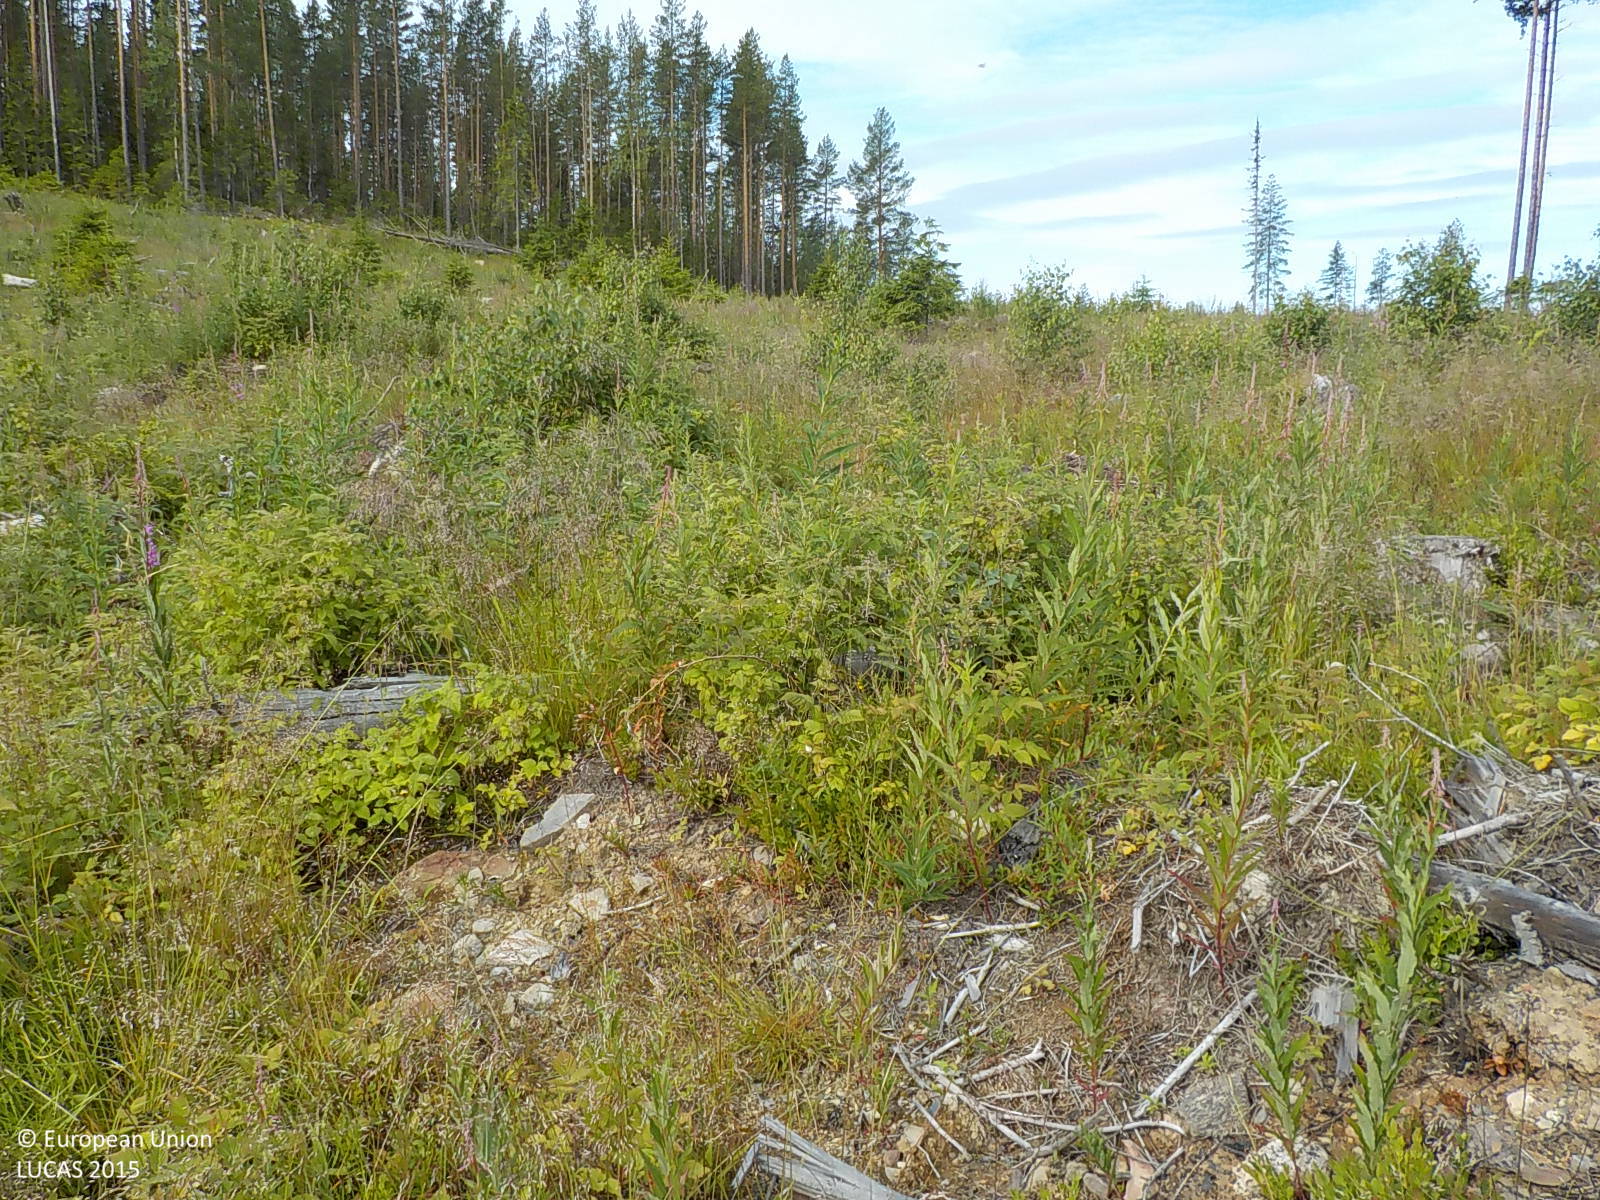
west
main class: Woodland
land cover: Other mixed woodland
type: boreal forest
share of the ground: 25 - 50 %
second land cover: Grassland without tree/shrub cover
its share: 25 - 50 %
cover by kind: herbaceous plants 35 %, coniferous forest trees 30 %, broadleaved forest trees 30 %, shrubs 5 %
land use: Forestry
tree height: < 5 m
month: July
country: SE
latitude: 63.2015
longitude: 17.1923
